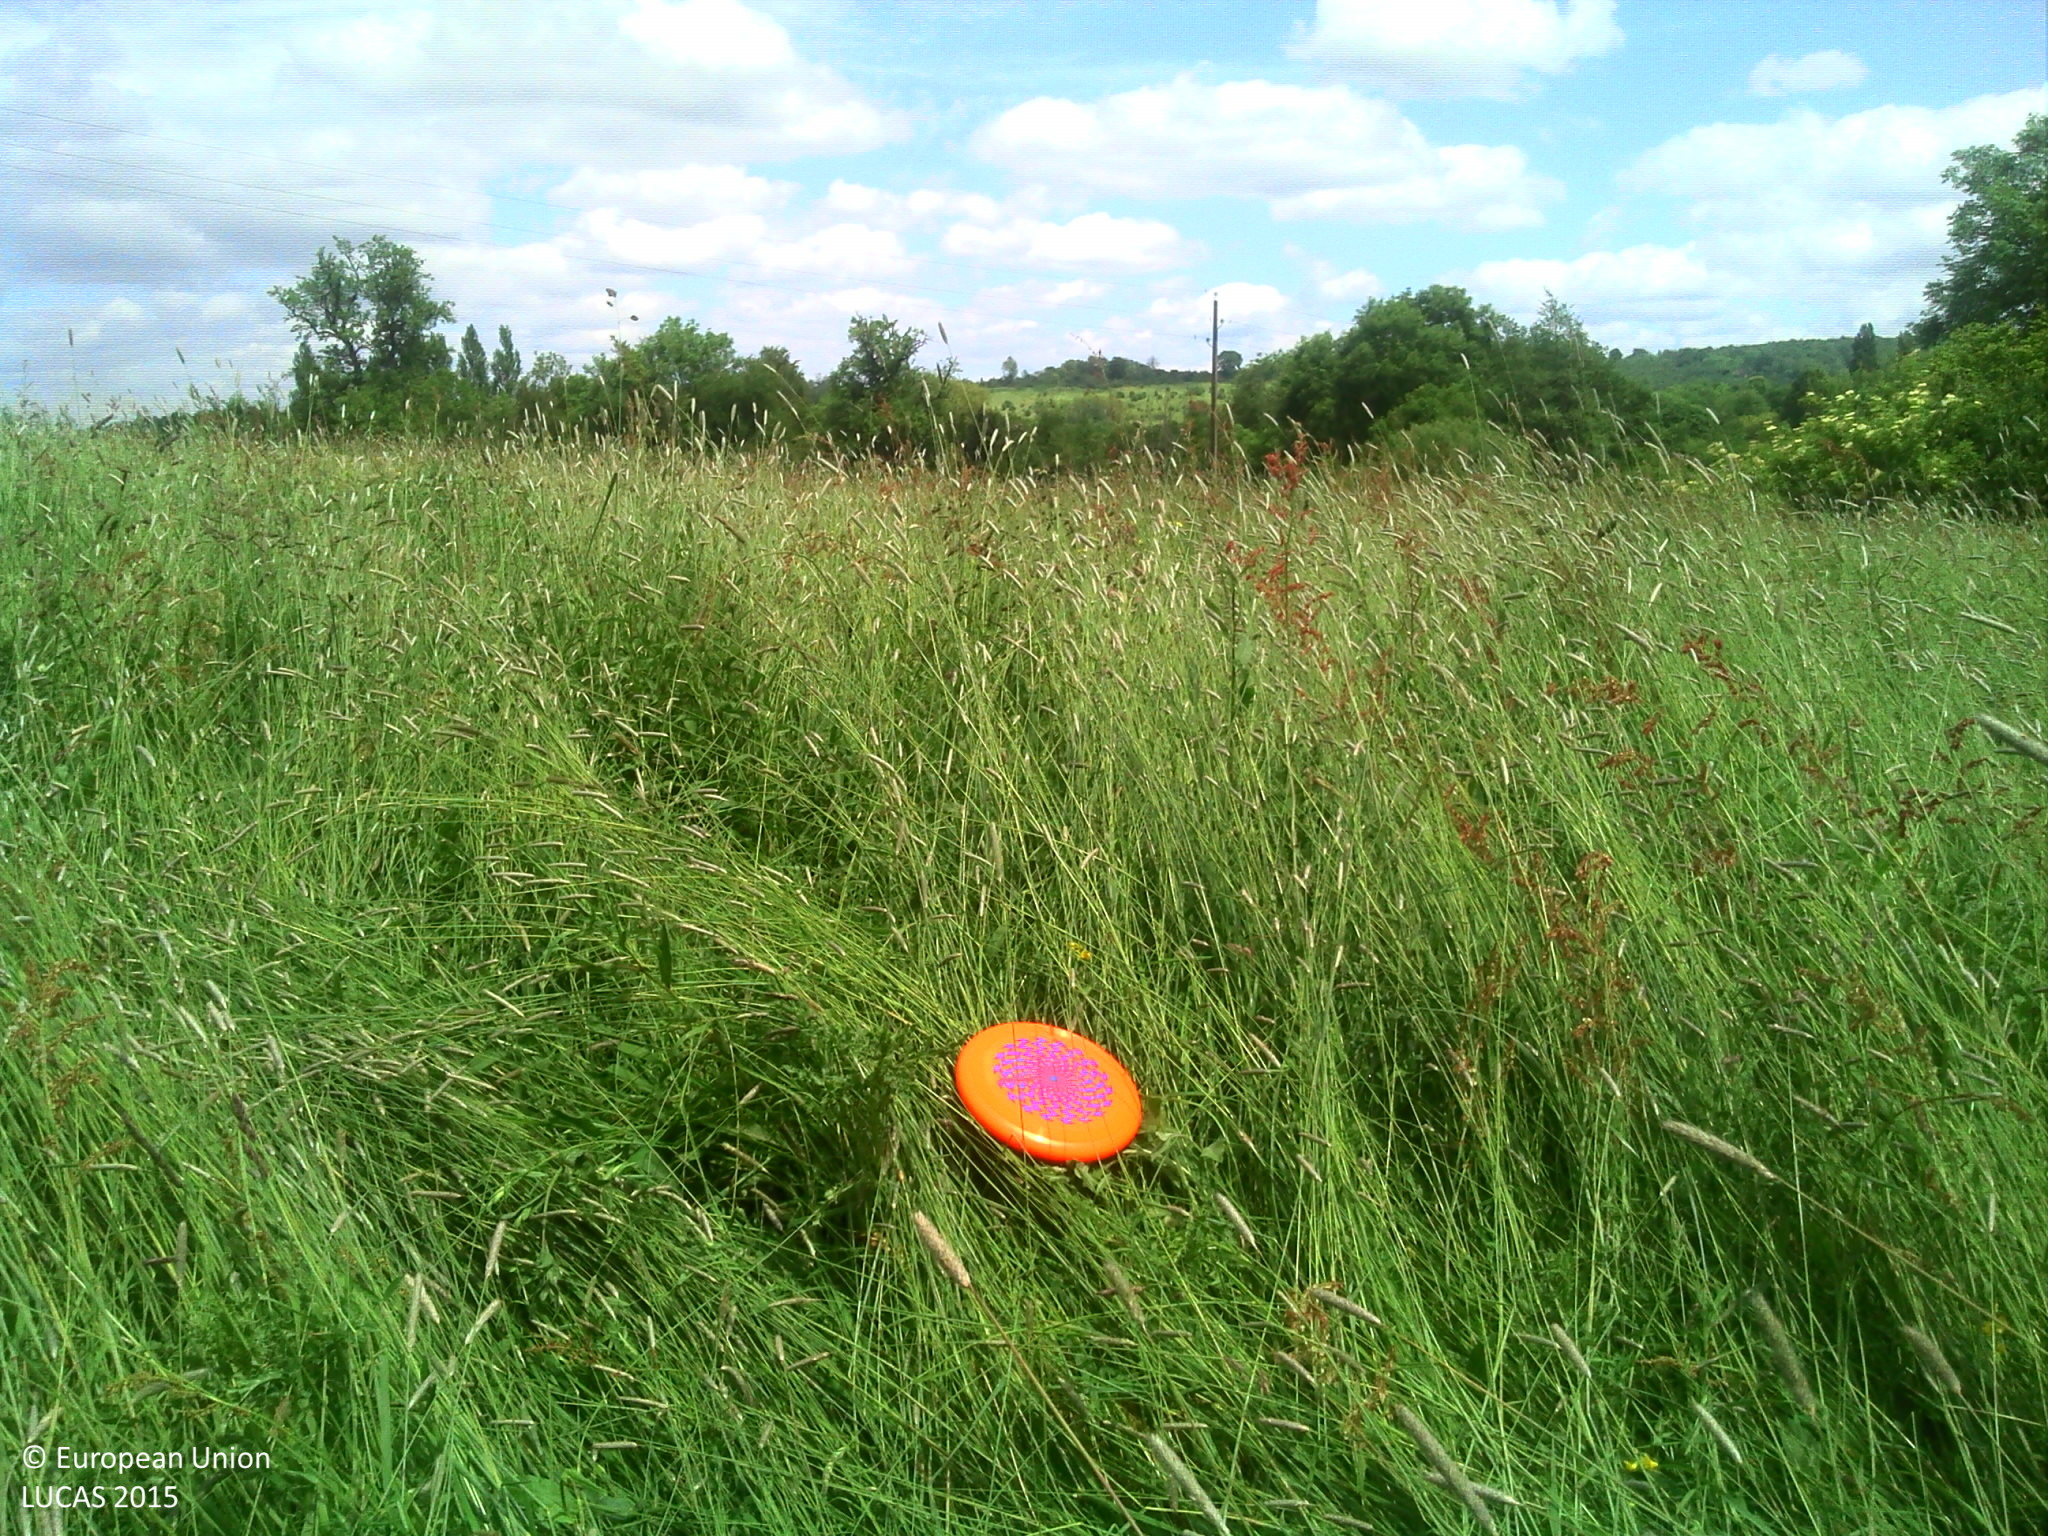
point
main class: Grassland
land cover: Grassland without tree/shrub cover
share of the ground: > 75 %
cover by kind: herbaceous plants 95 %
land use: Agriculture (excluding fallow land and kitchen gardens)
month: June
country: FR
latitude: 48.8989
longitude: 0.0804
